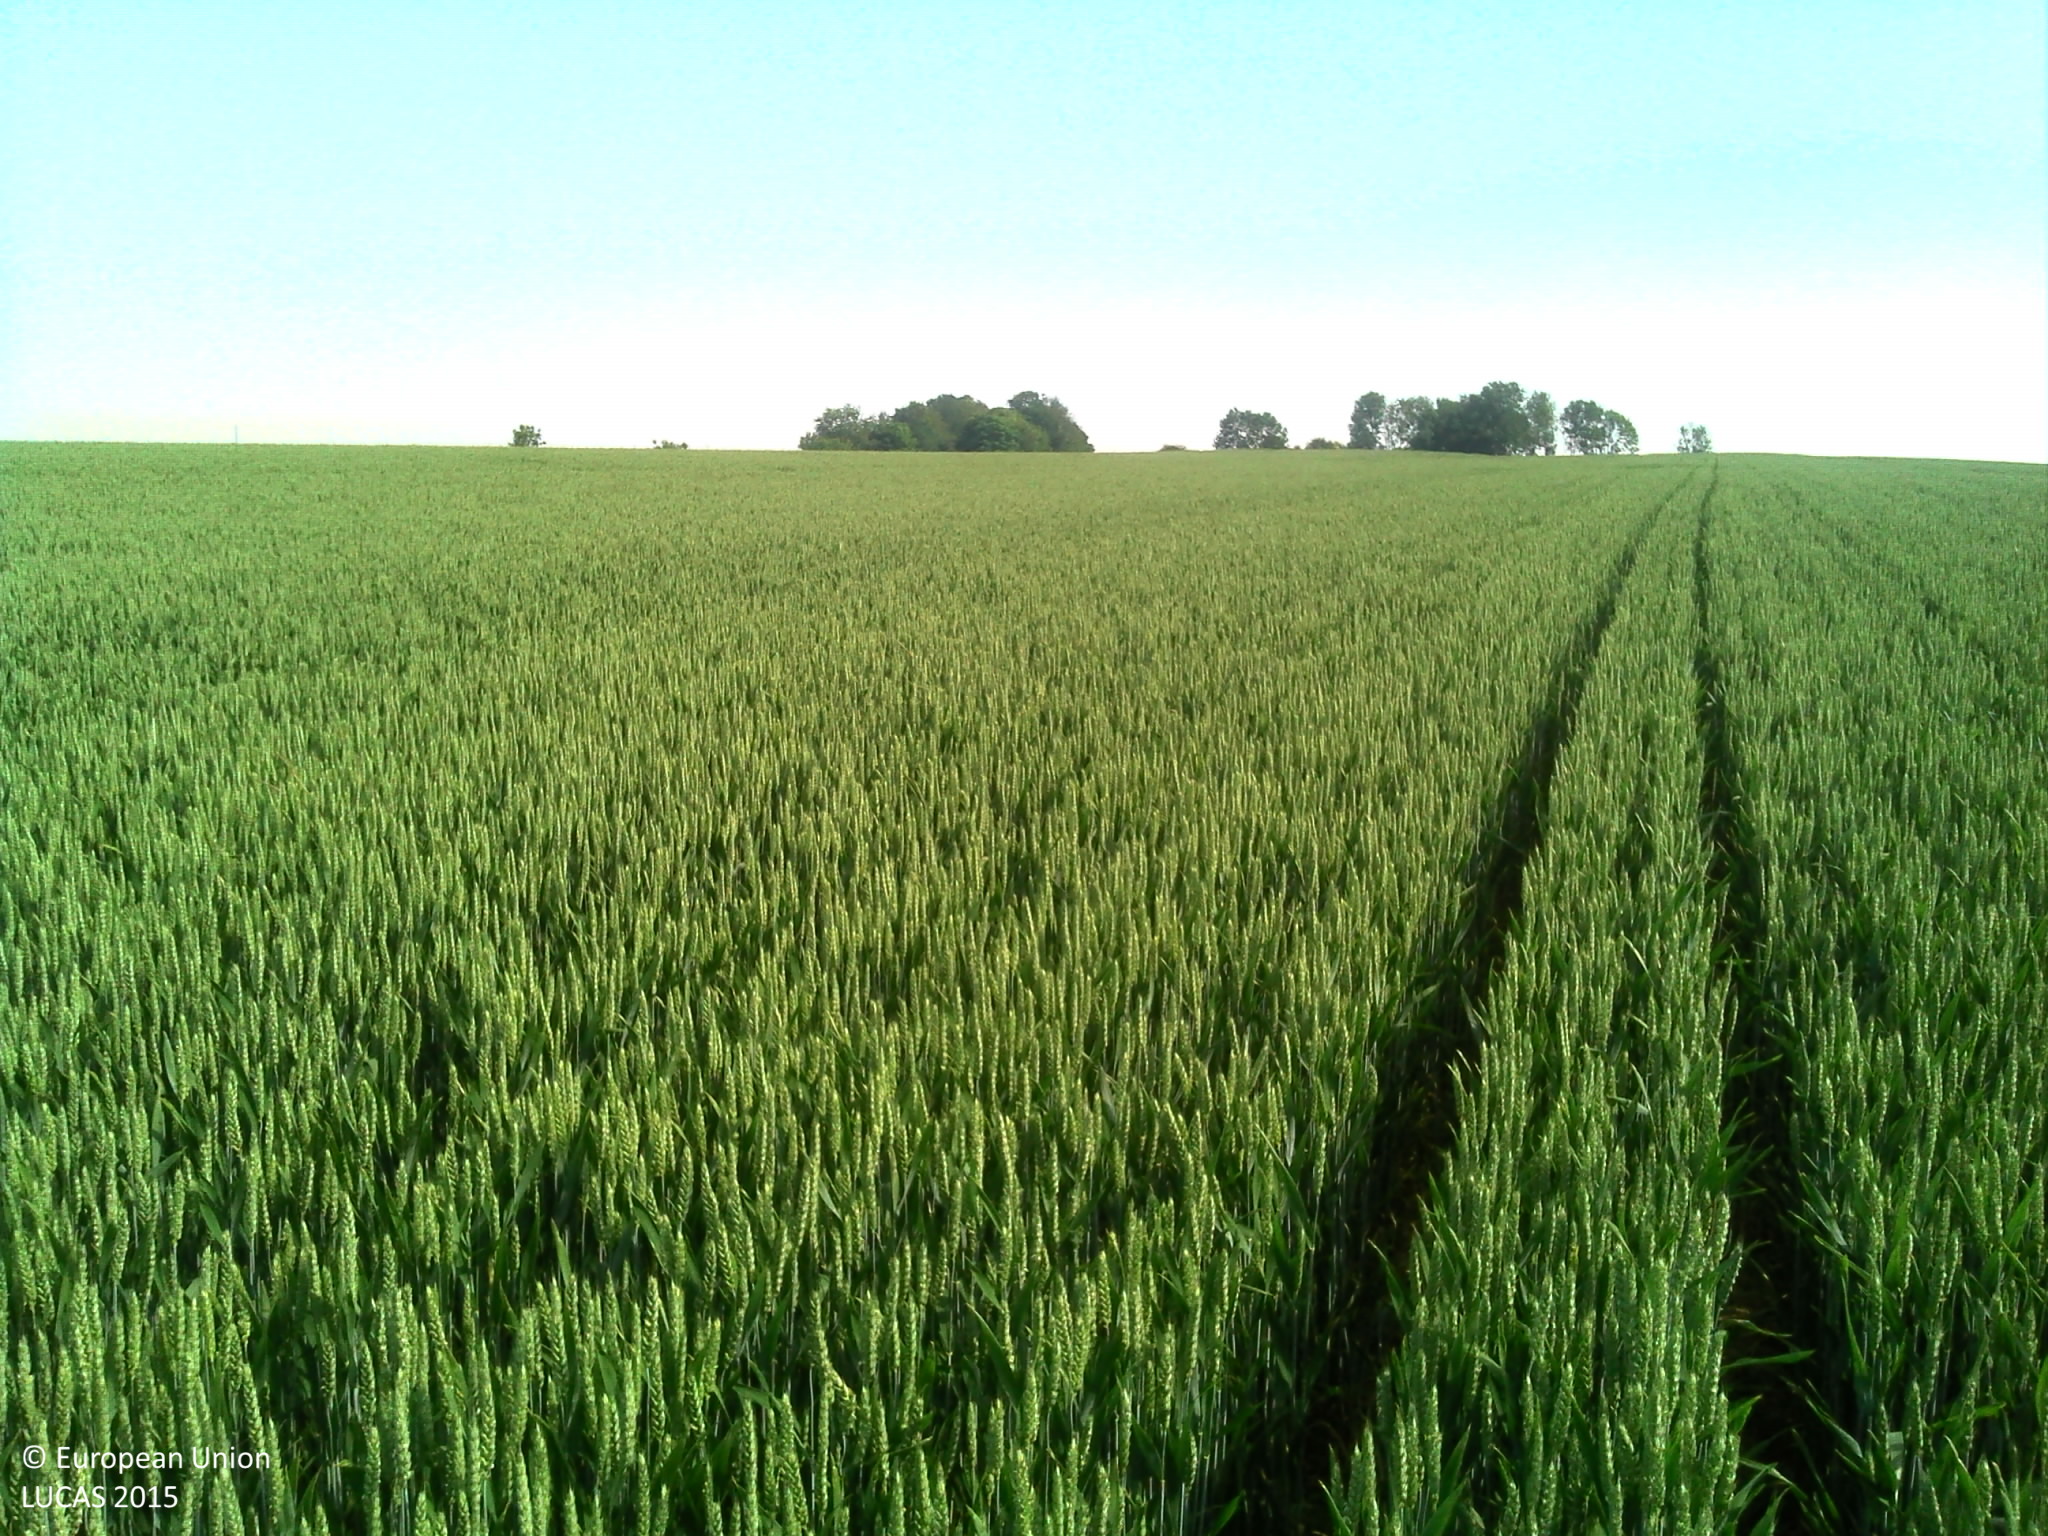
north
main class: Cropland
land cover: Common wheat
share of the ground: > 75 %
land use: Agriculture (excluding fallow land and kitchen gardens)
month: June
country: FR
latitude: 49.8116
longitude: 4.0329
